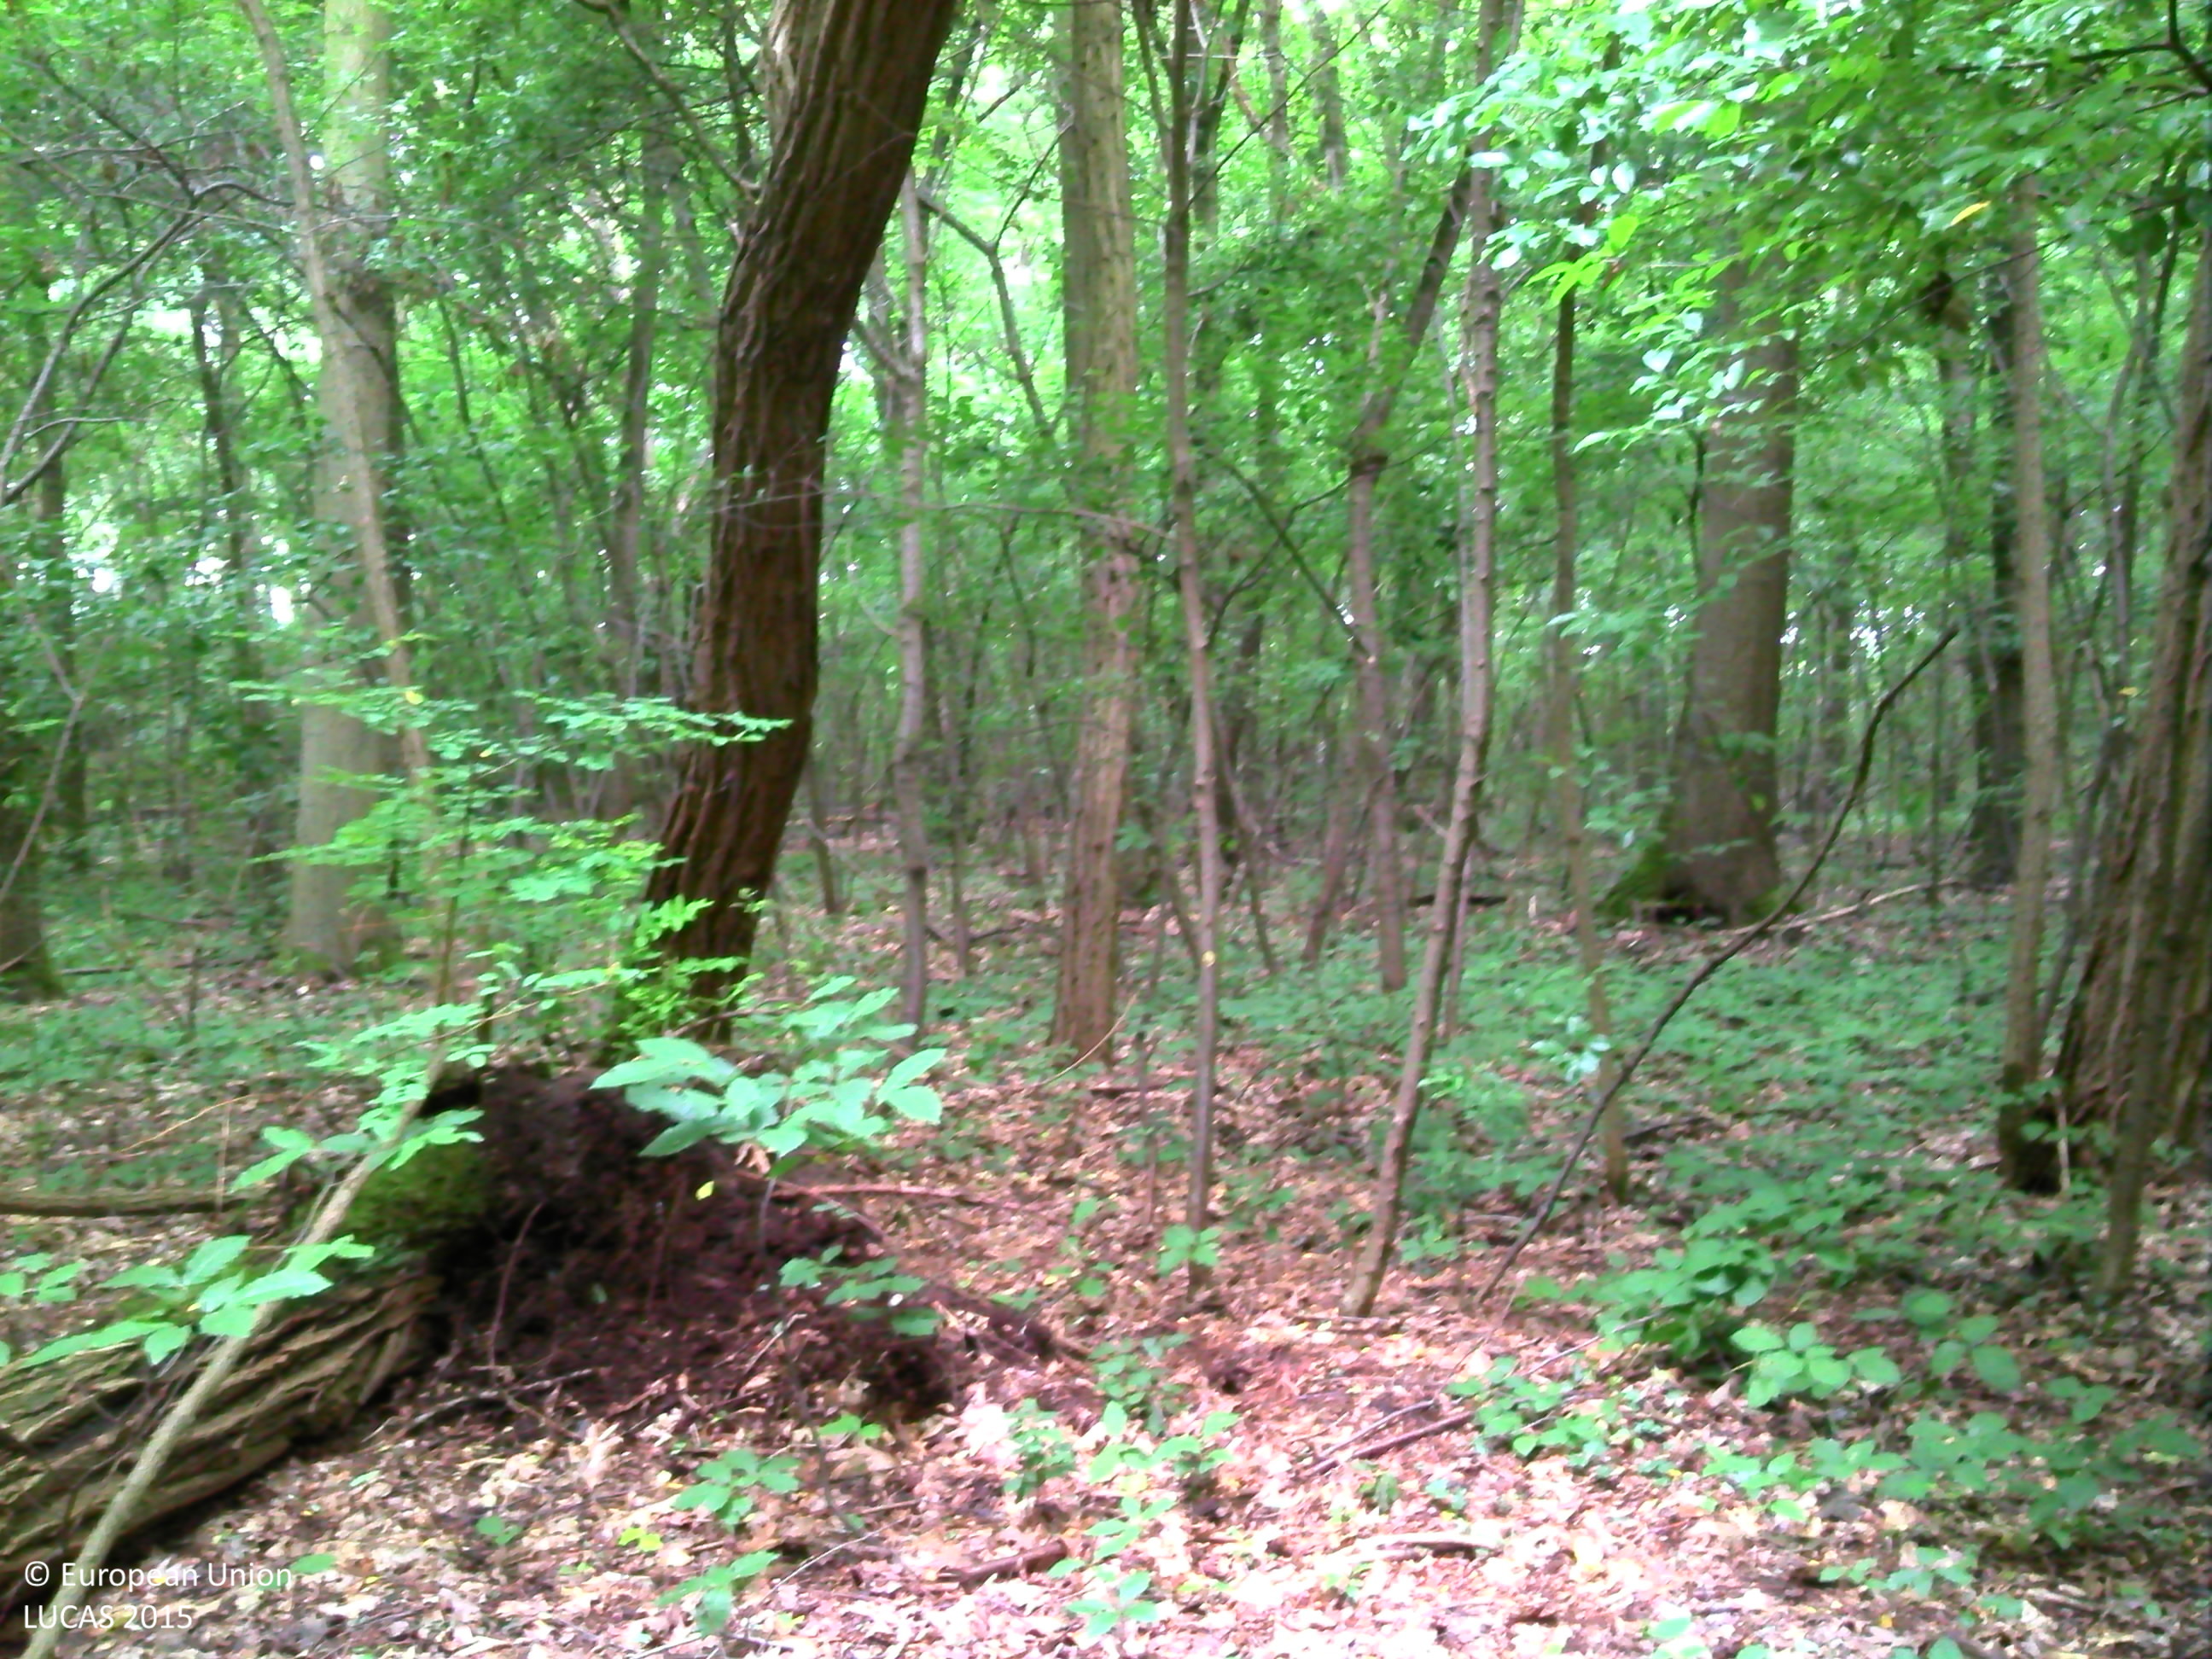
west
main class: Woodland
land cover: Broadleaved woodland
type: acidophilous oak and oak-birch forest
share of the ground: > 75 %
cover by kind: broadleaved forest trees 90 %, herbaceous plants 10 %
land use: Forestry
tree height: > 5 m
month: August
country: BE
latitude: 50.9678
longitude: 4.8276
